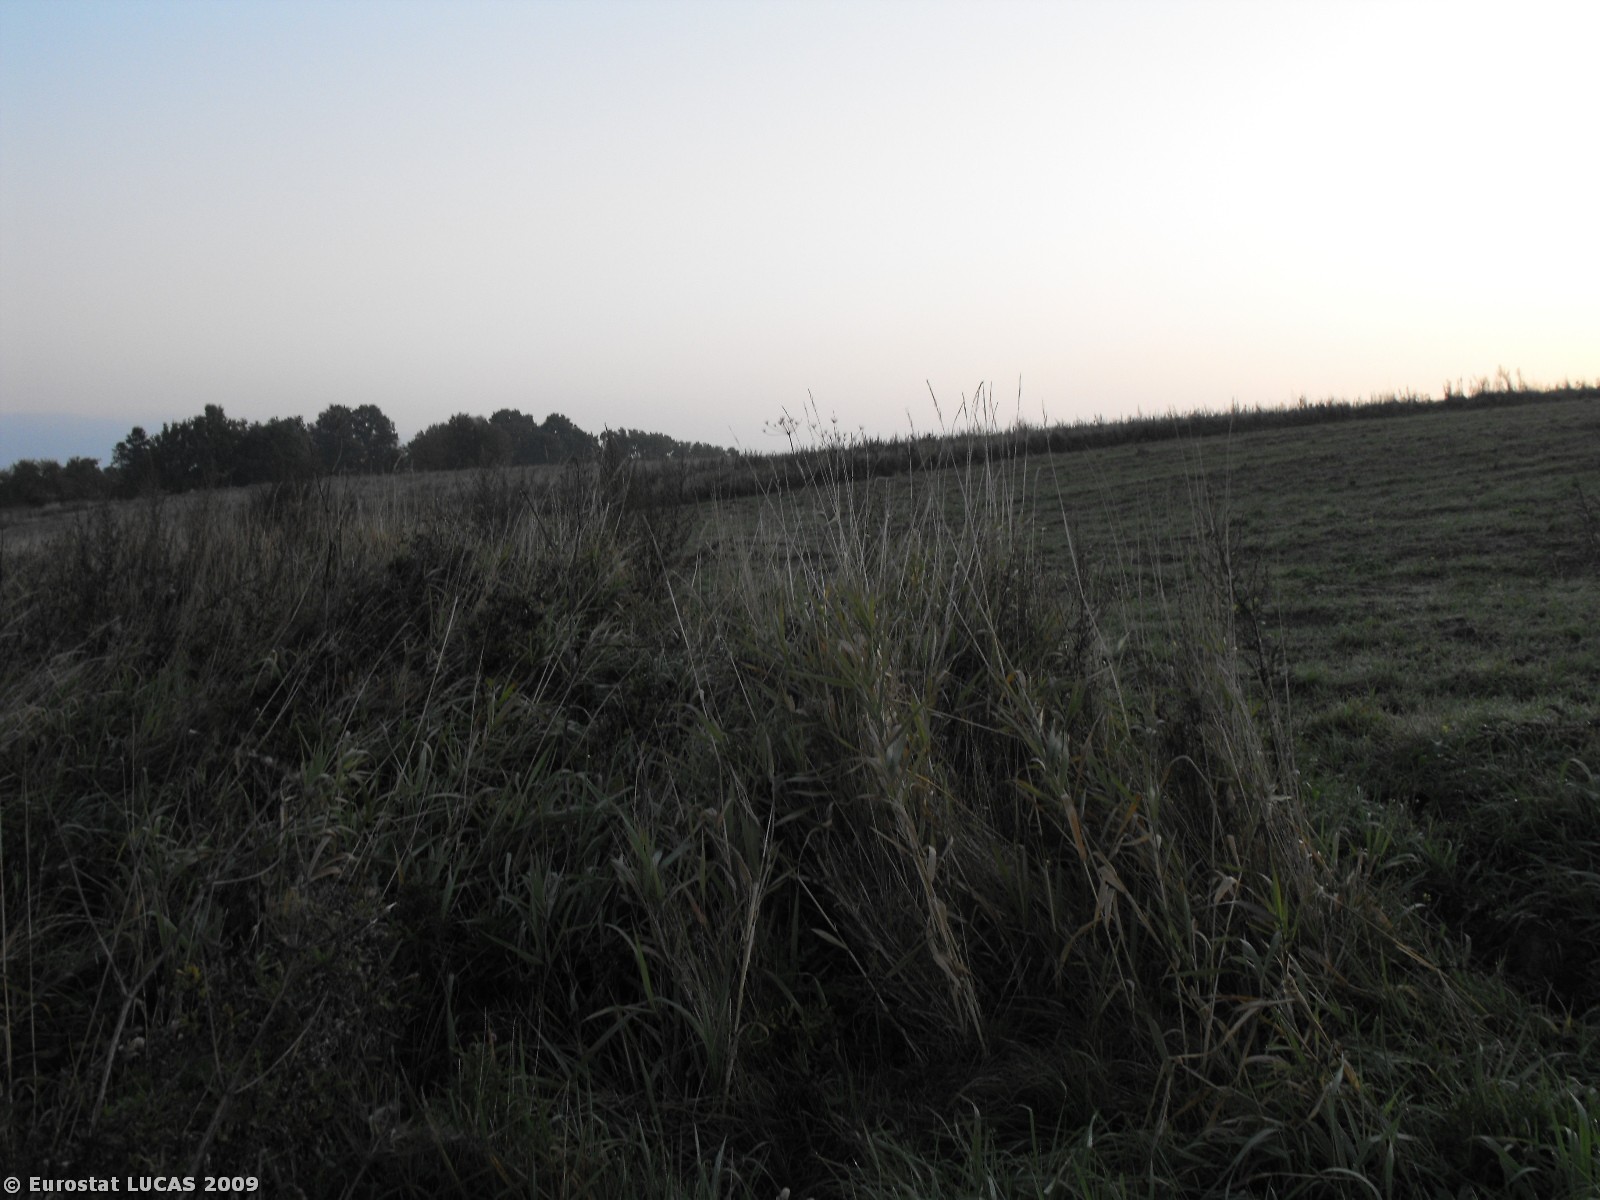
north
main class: Grassland
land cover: Spontaneously vegetated surfaces
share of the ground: > 75 %
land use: Unused
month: September
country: PL
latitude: 54.4585
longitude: 16.7478
